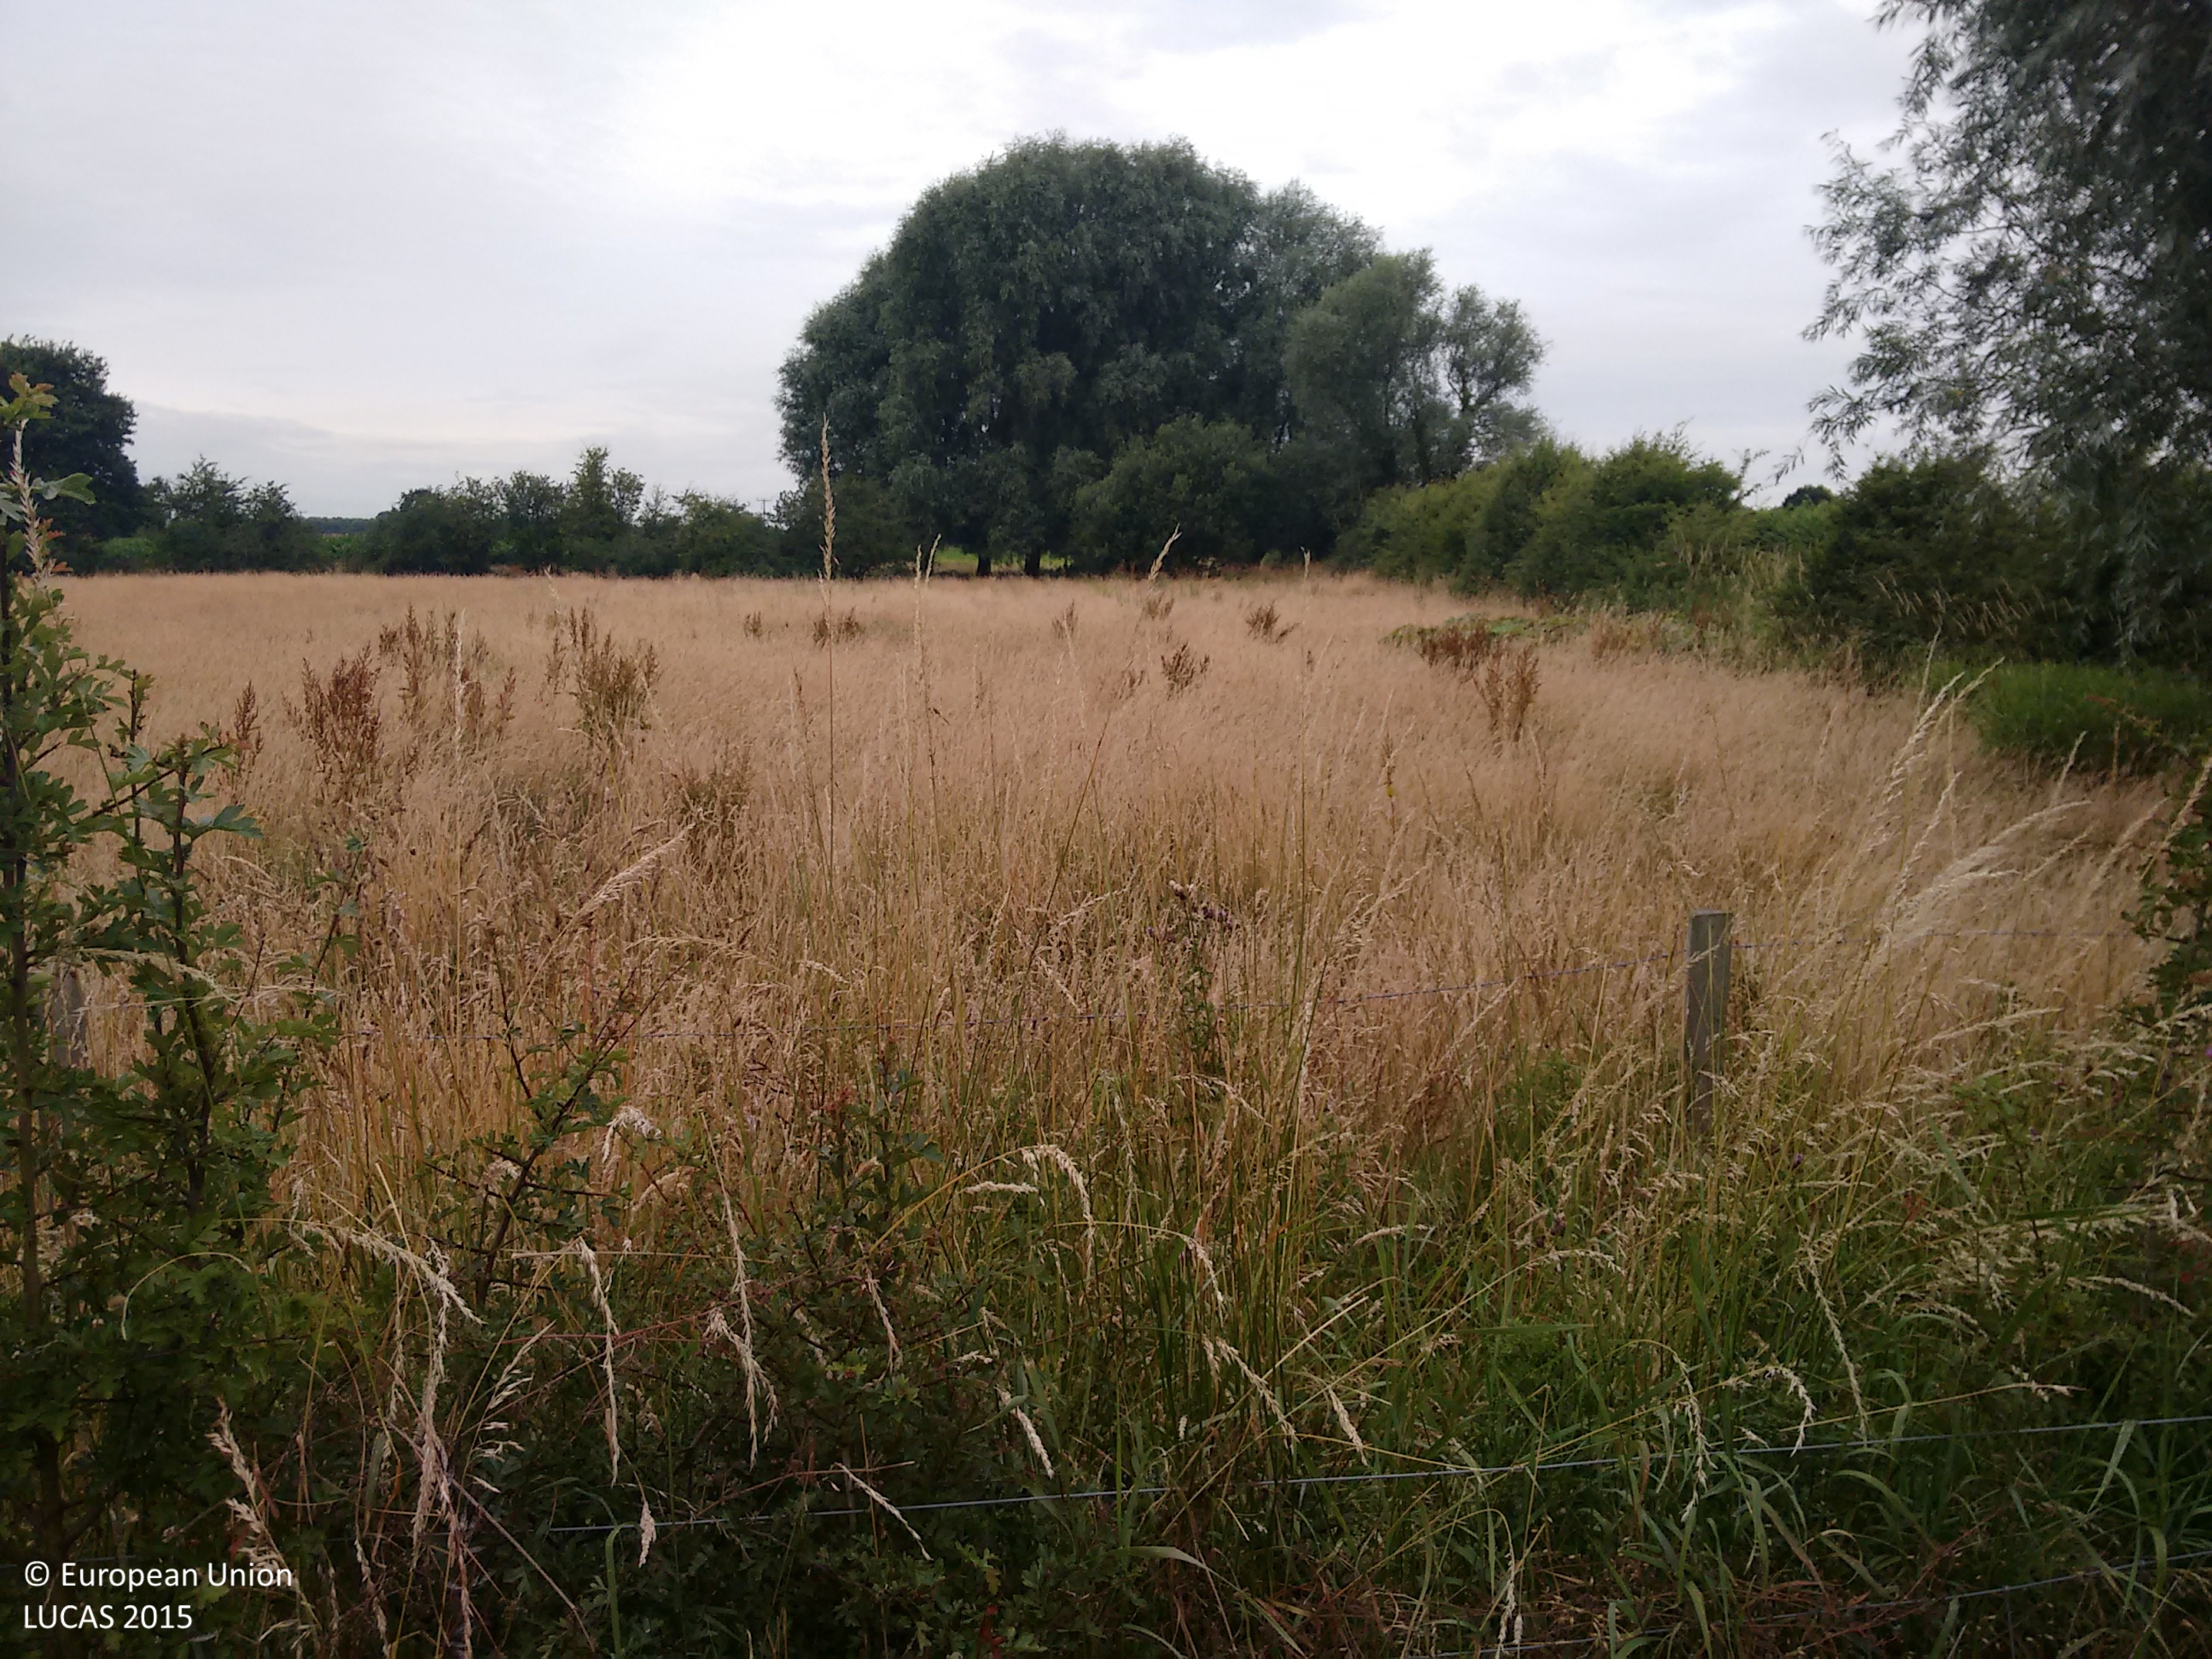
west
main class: Grassland
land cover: Grassland without tree/shrub cover
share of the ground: > 75 %
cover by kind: herbaceous plants 100 %
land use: Agriculture (excluding fallow land and kitchen gardens)
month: July
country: GB
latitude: 53.0969
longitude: -1.0206
